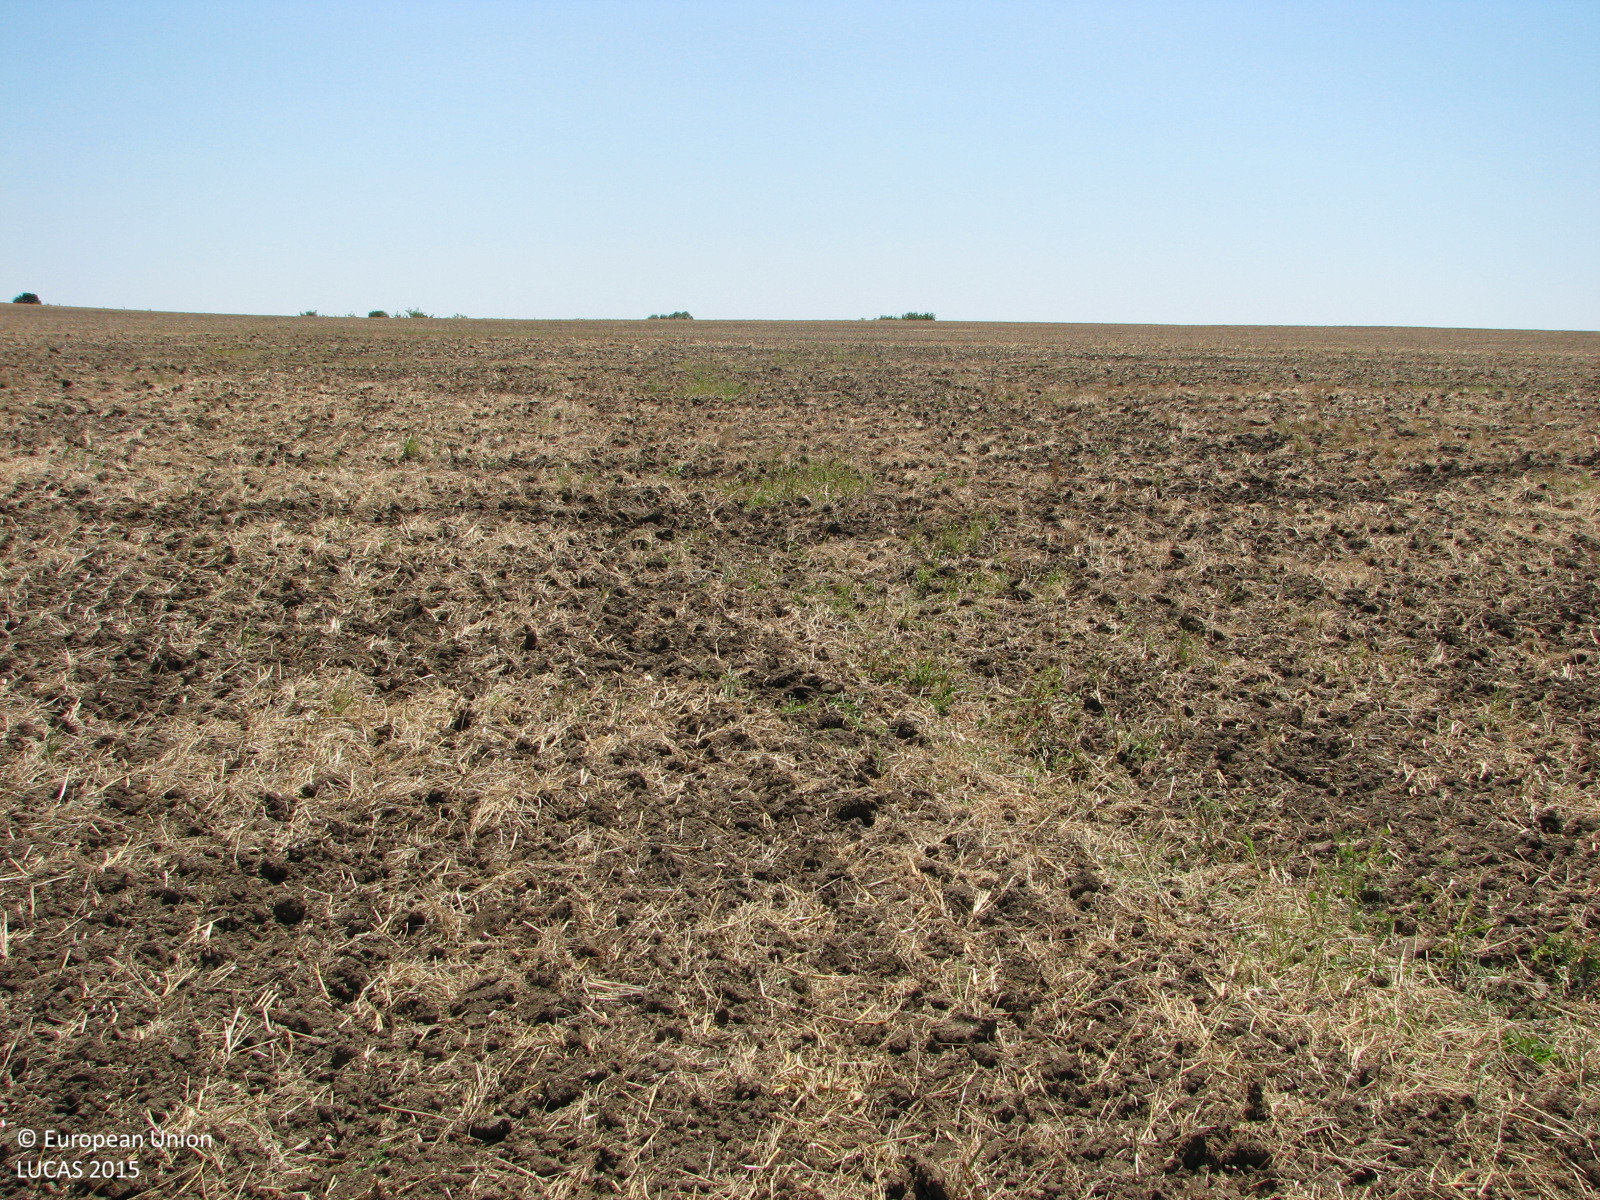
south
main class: Cropland
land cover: Common wheat
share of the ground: < 10 %
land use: Agriculture (excluding fallow land and kitchen gardens)
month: July
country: BG
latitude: 42.2240
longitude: 26.8528
